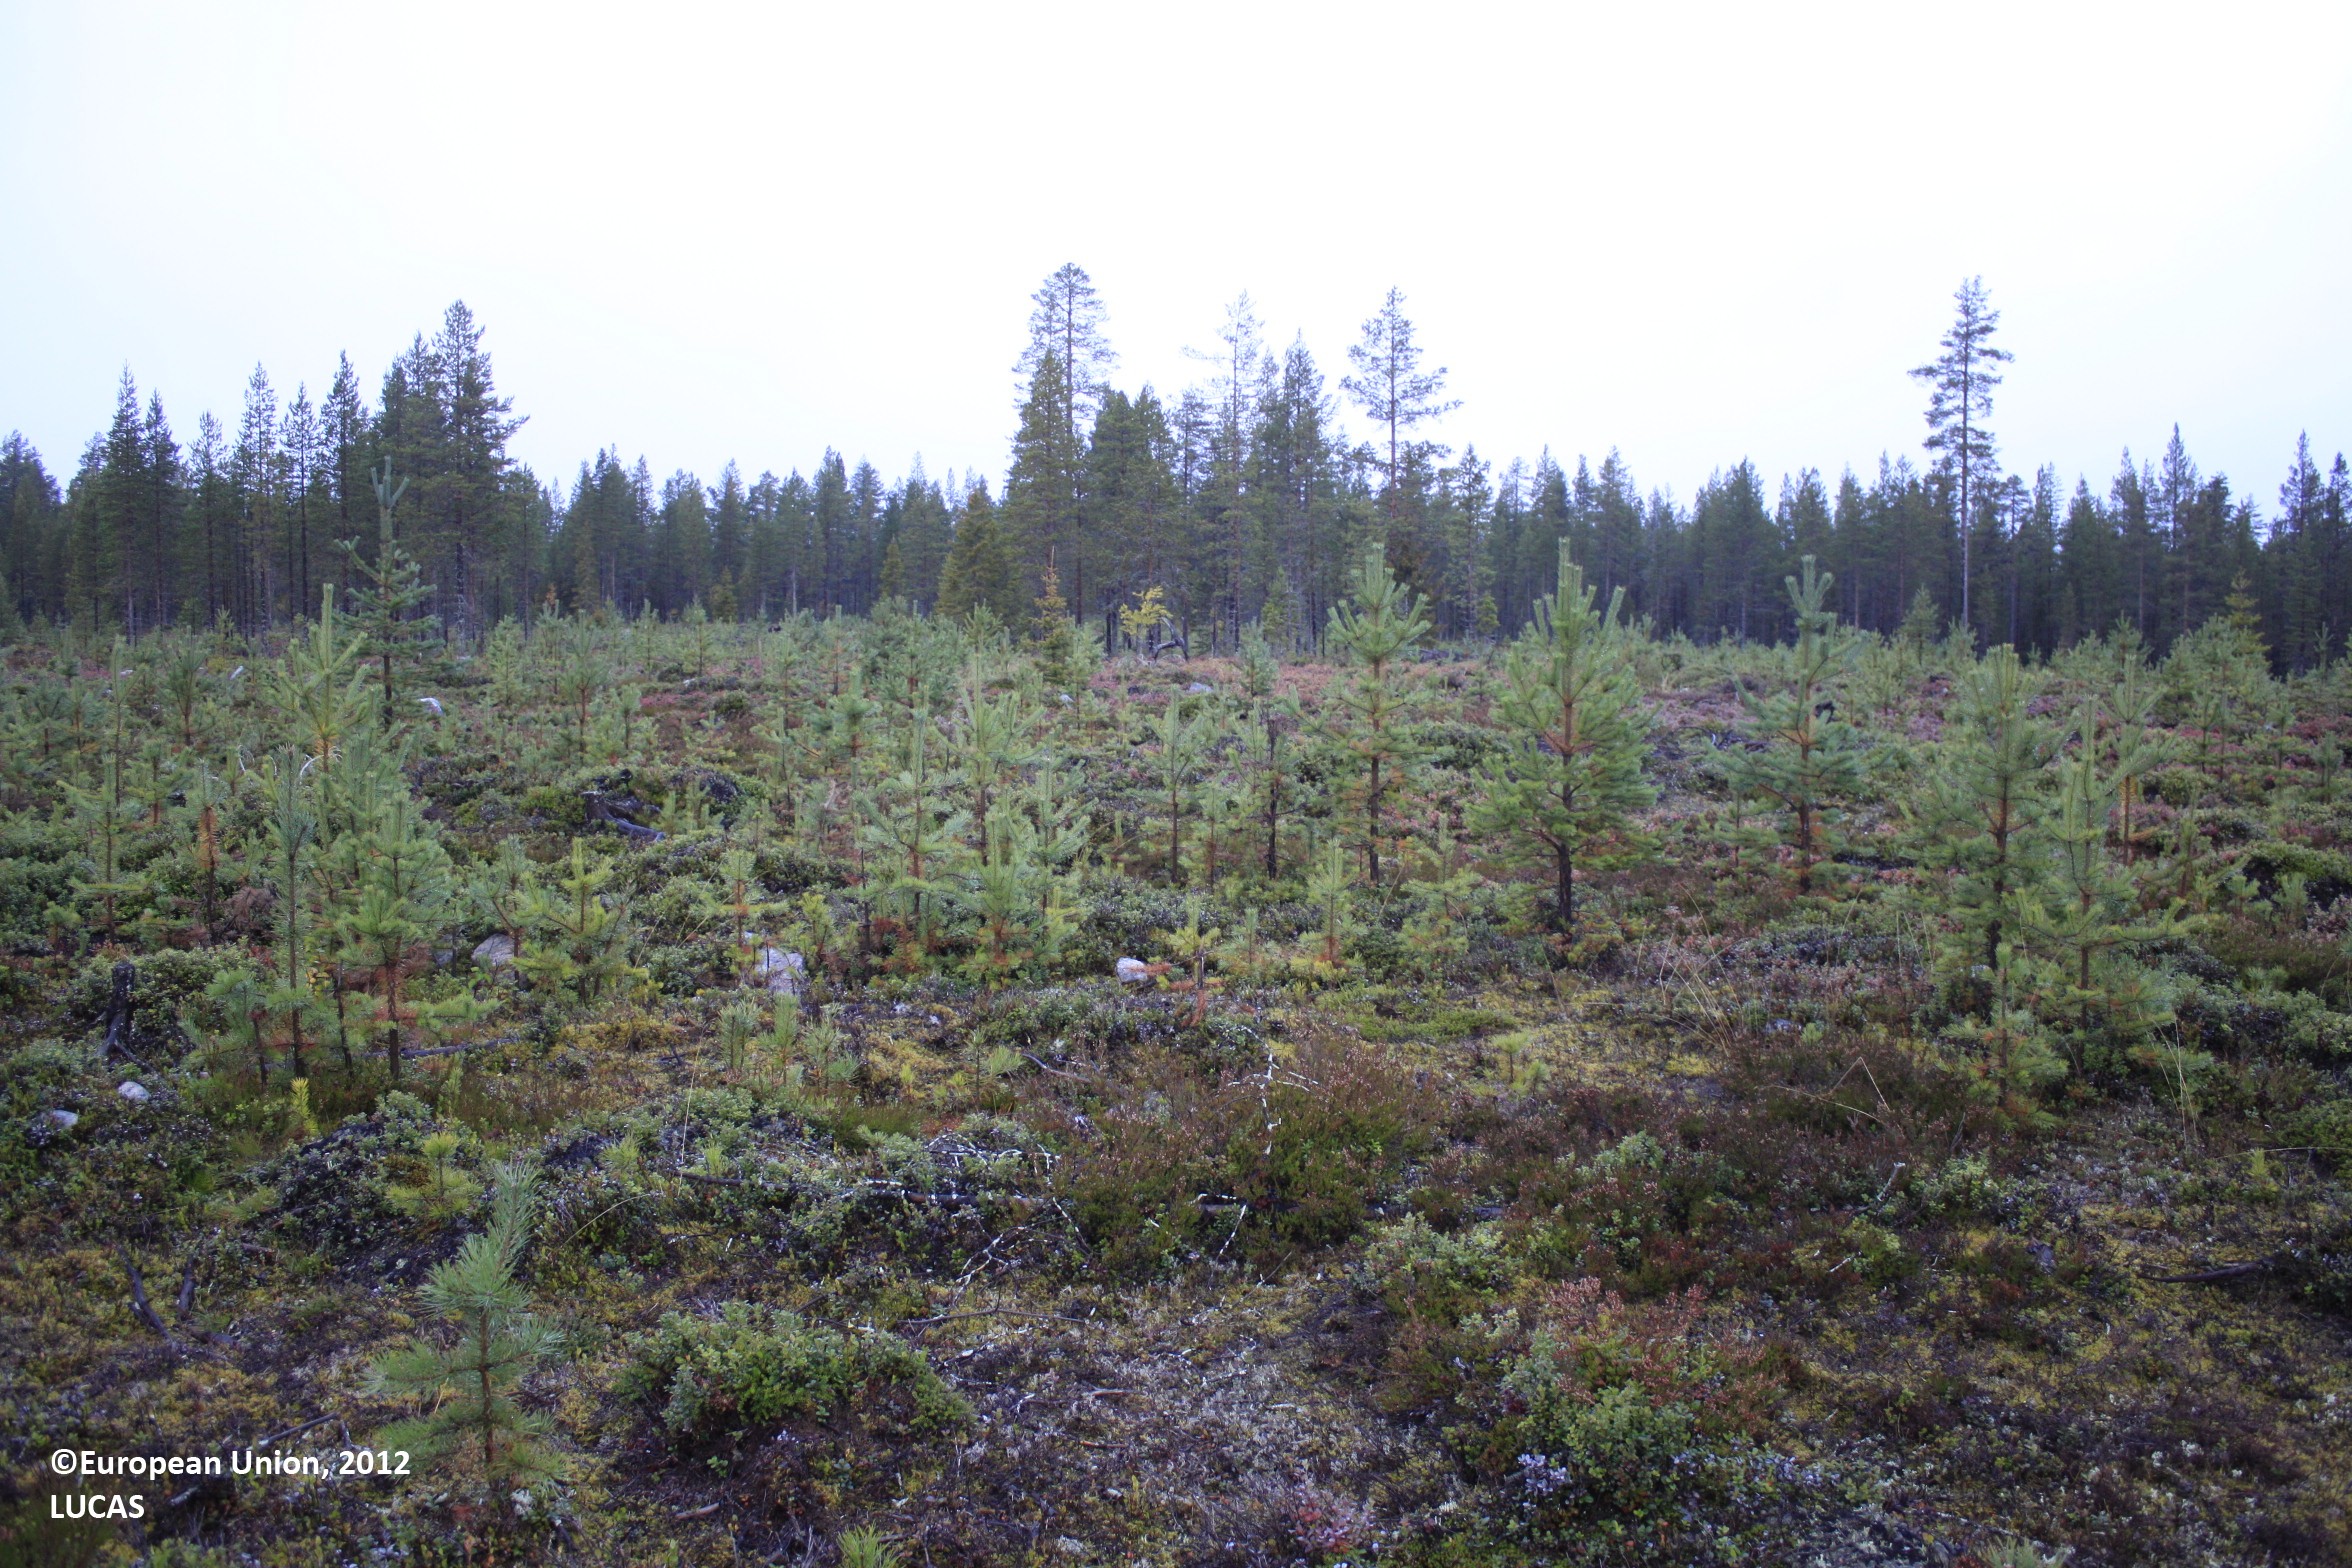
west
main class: Woodland
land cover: Pine dominated coniferous woodland
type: boreal forest
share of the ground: 10 - 25 %
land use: Forestry
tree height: < 5 m
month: September
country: FI
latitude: 66.0205
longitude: 26.7943
